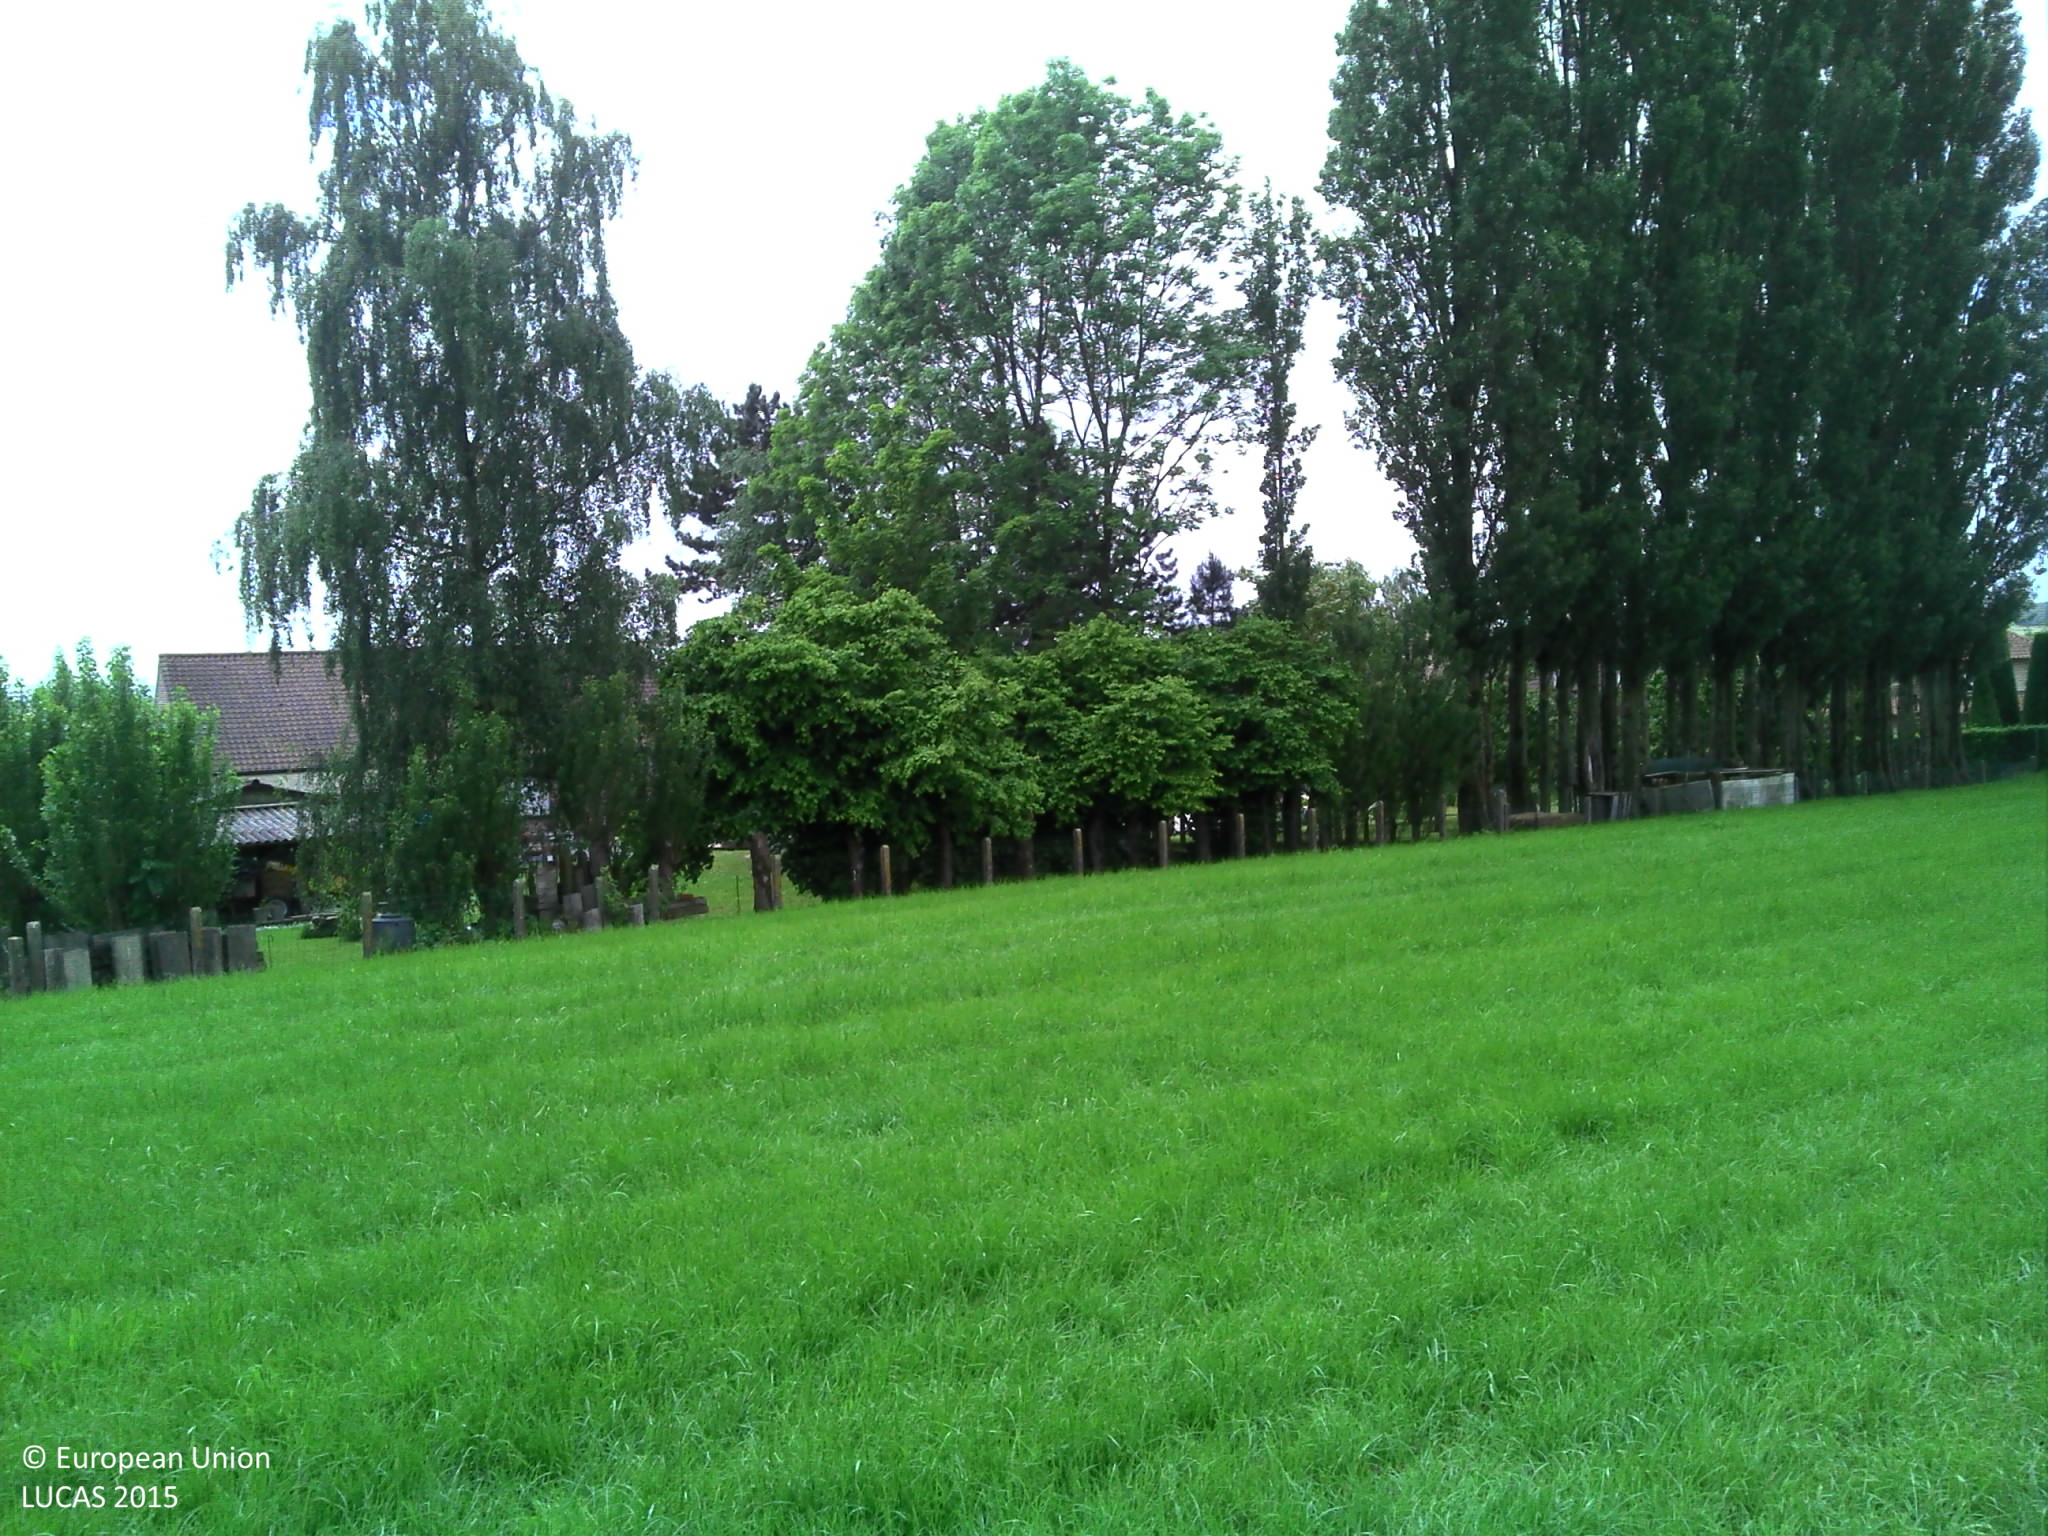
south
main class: Cropland
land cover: Temporary grasslands
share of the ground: > 75 %
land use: Agriculture (excluding fallow land and kitchen gardens)
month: June
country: BE
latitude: 50.8288
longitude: 3.5040
